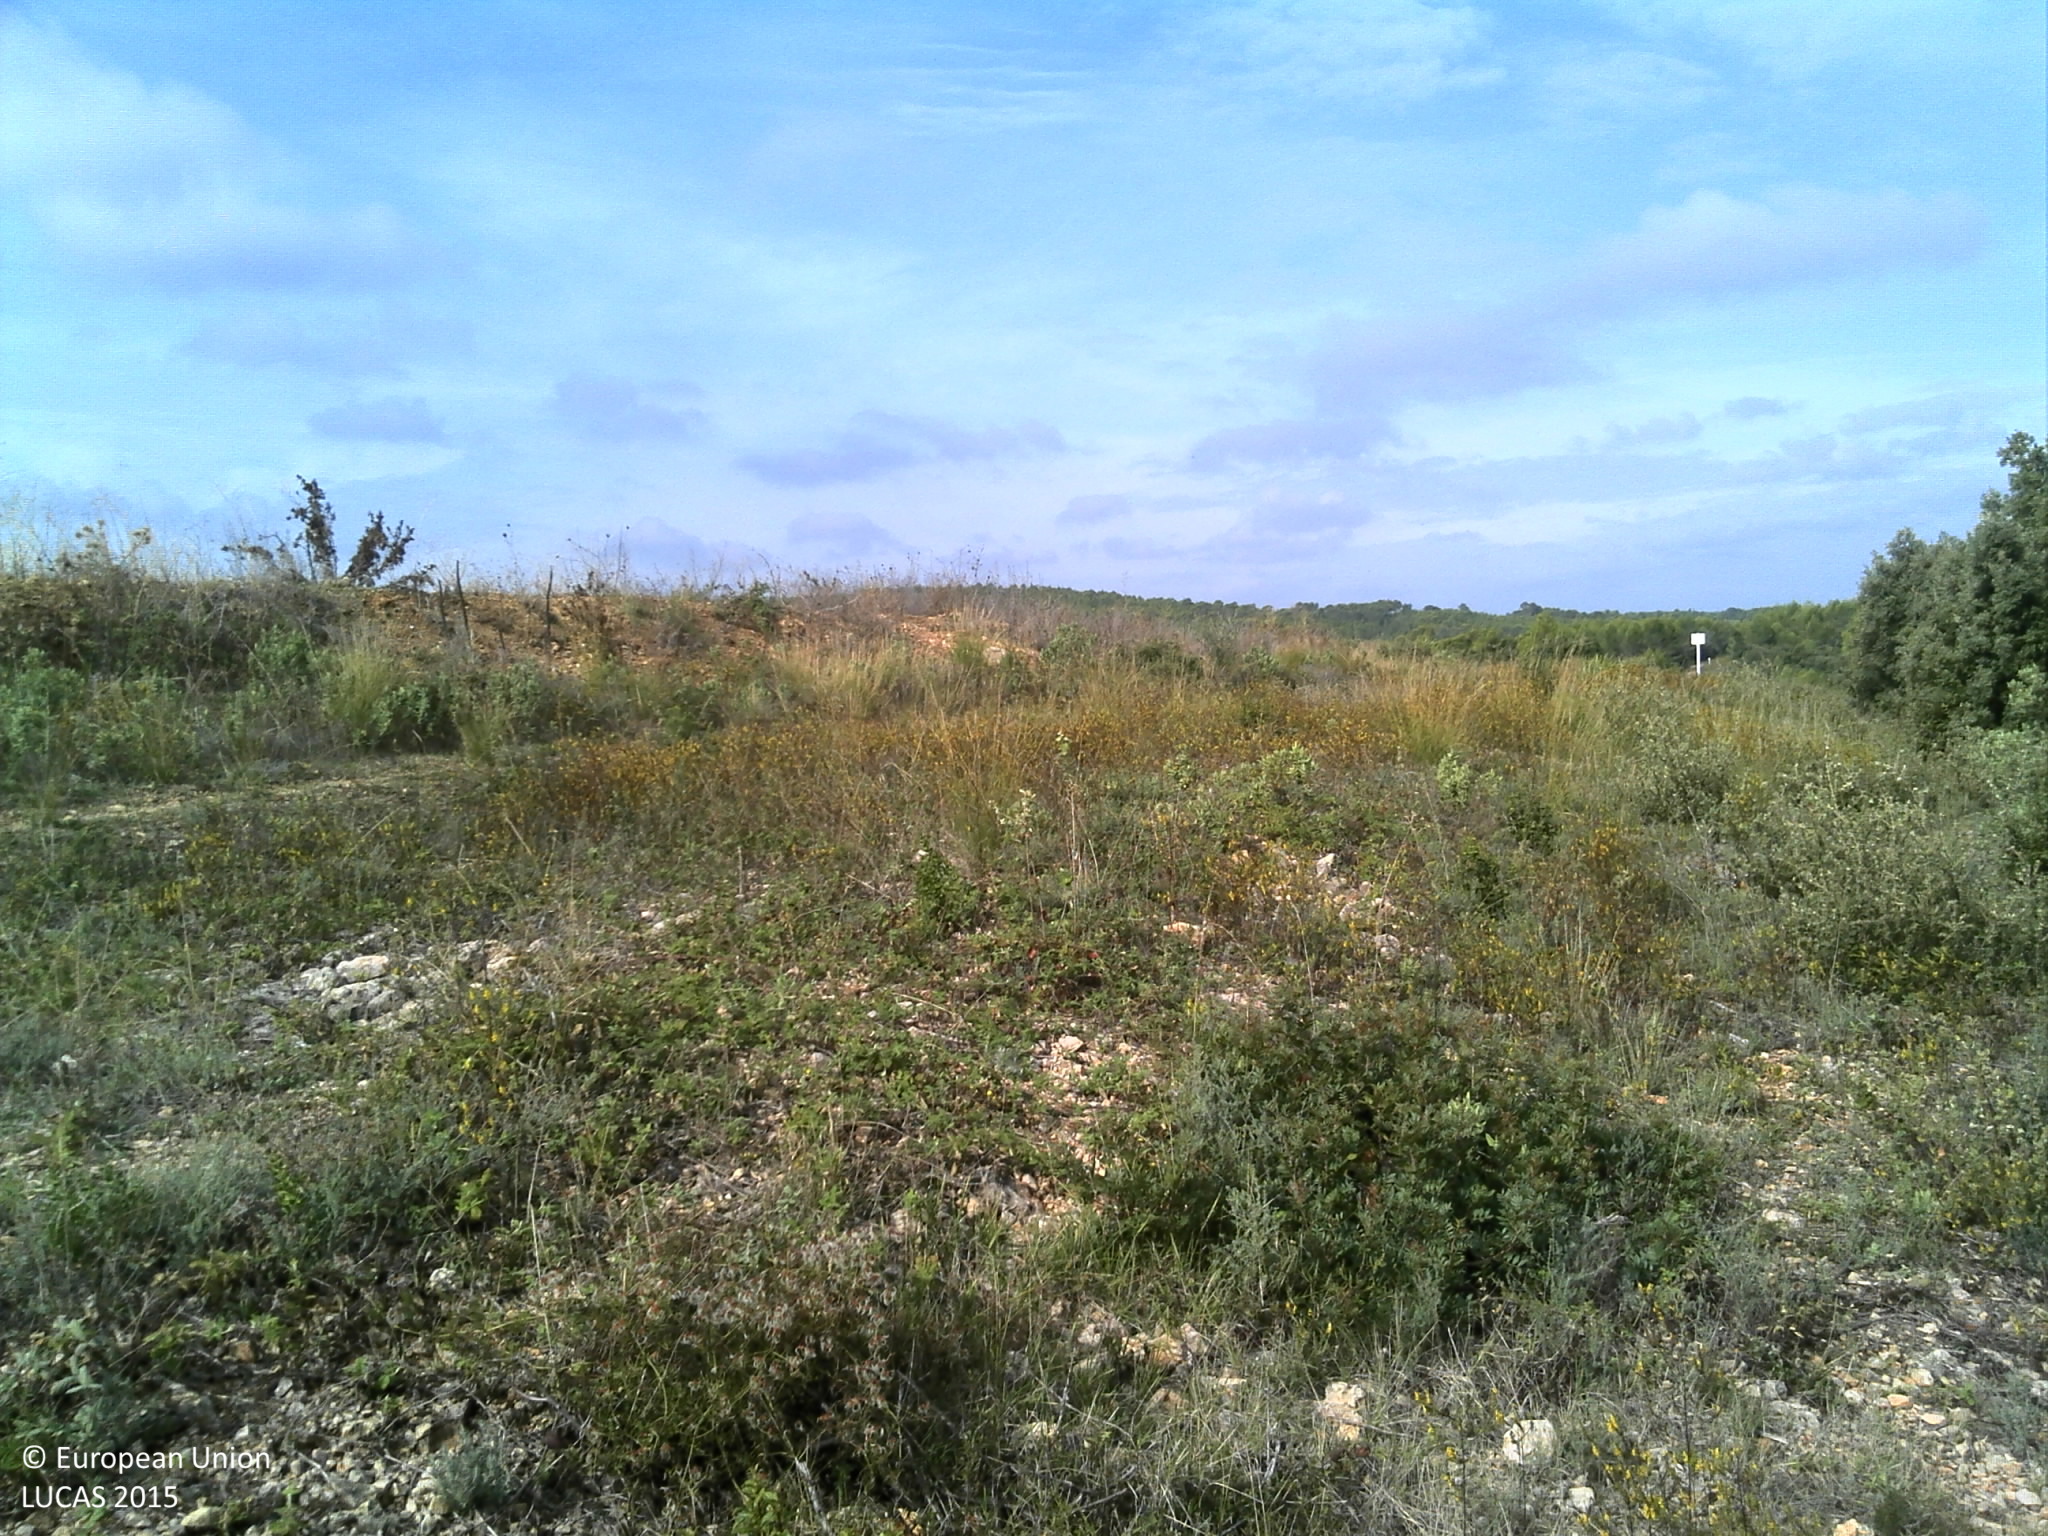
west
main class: Woodland
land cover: Broadleaved woodland
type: broadleaved evergreen forest
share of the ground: > 75 %
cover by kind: broadleaved forest trees 80 %, shrubs 10 %, unconsolidated bare surface 10 %
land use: Semi-natural and natural areas not in use
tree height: < 5 m
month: October
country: FR
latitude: 43.4793
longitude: 6.5097
